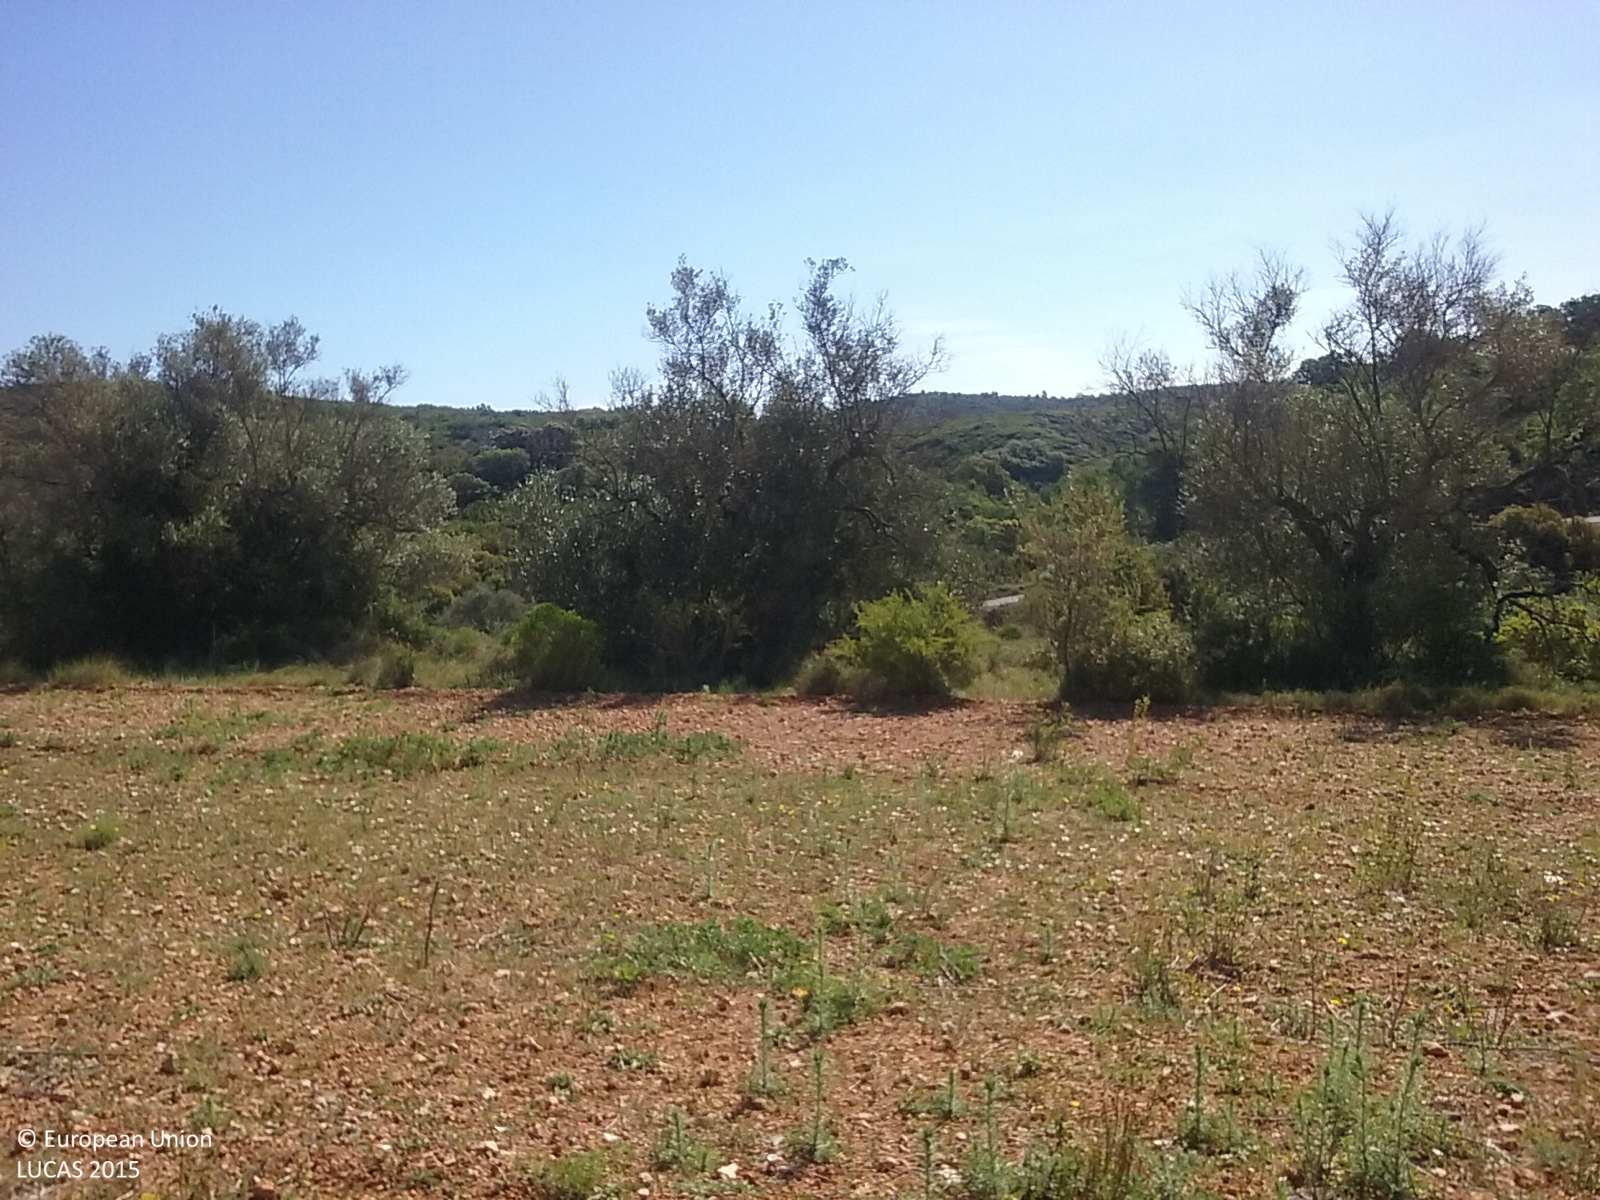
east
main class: Grassland
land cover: Spontaneously vegetated surfaces
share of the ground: 50 - 75 %
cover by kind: herbaceous plants 70 %, unconsolidated bare surface 30 %
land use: Fallow land
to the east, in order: Spontaneously vegetated surfaces; Dry stone walls; Olive groves; Grassland without tree/shrub cover; Dry stone walls; Grassland without tree/shrub cover; Shrubland without tree cover; Dry stone walls; Shrubland with sparse tree cover; Grassland without tree/shrub cover; Shrubland with sparse tree cover; Rocks and stones; Shrubland with sparse tree cover; Paved roads, cycling and walking lanes; Shrubland with sparse tree cover; Dry stone walls; Single bushes/trees; Rocks and stones; Shrubland without tree cover; Paved roads, cycling and walking lanes; Dry stone walls; Shruby margins; Grassland without tree/shrub cover; Dry stone walls; Shrubland with sparse tree cover; Dry stone walls; Shrubland with sparse tree cover
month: May
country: ES
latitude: 40.4382
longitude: 0.2702
